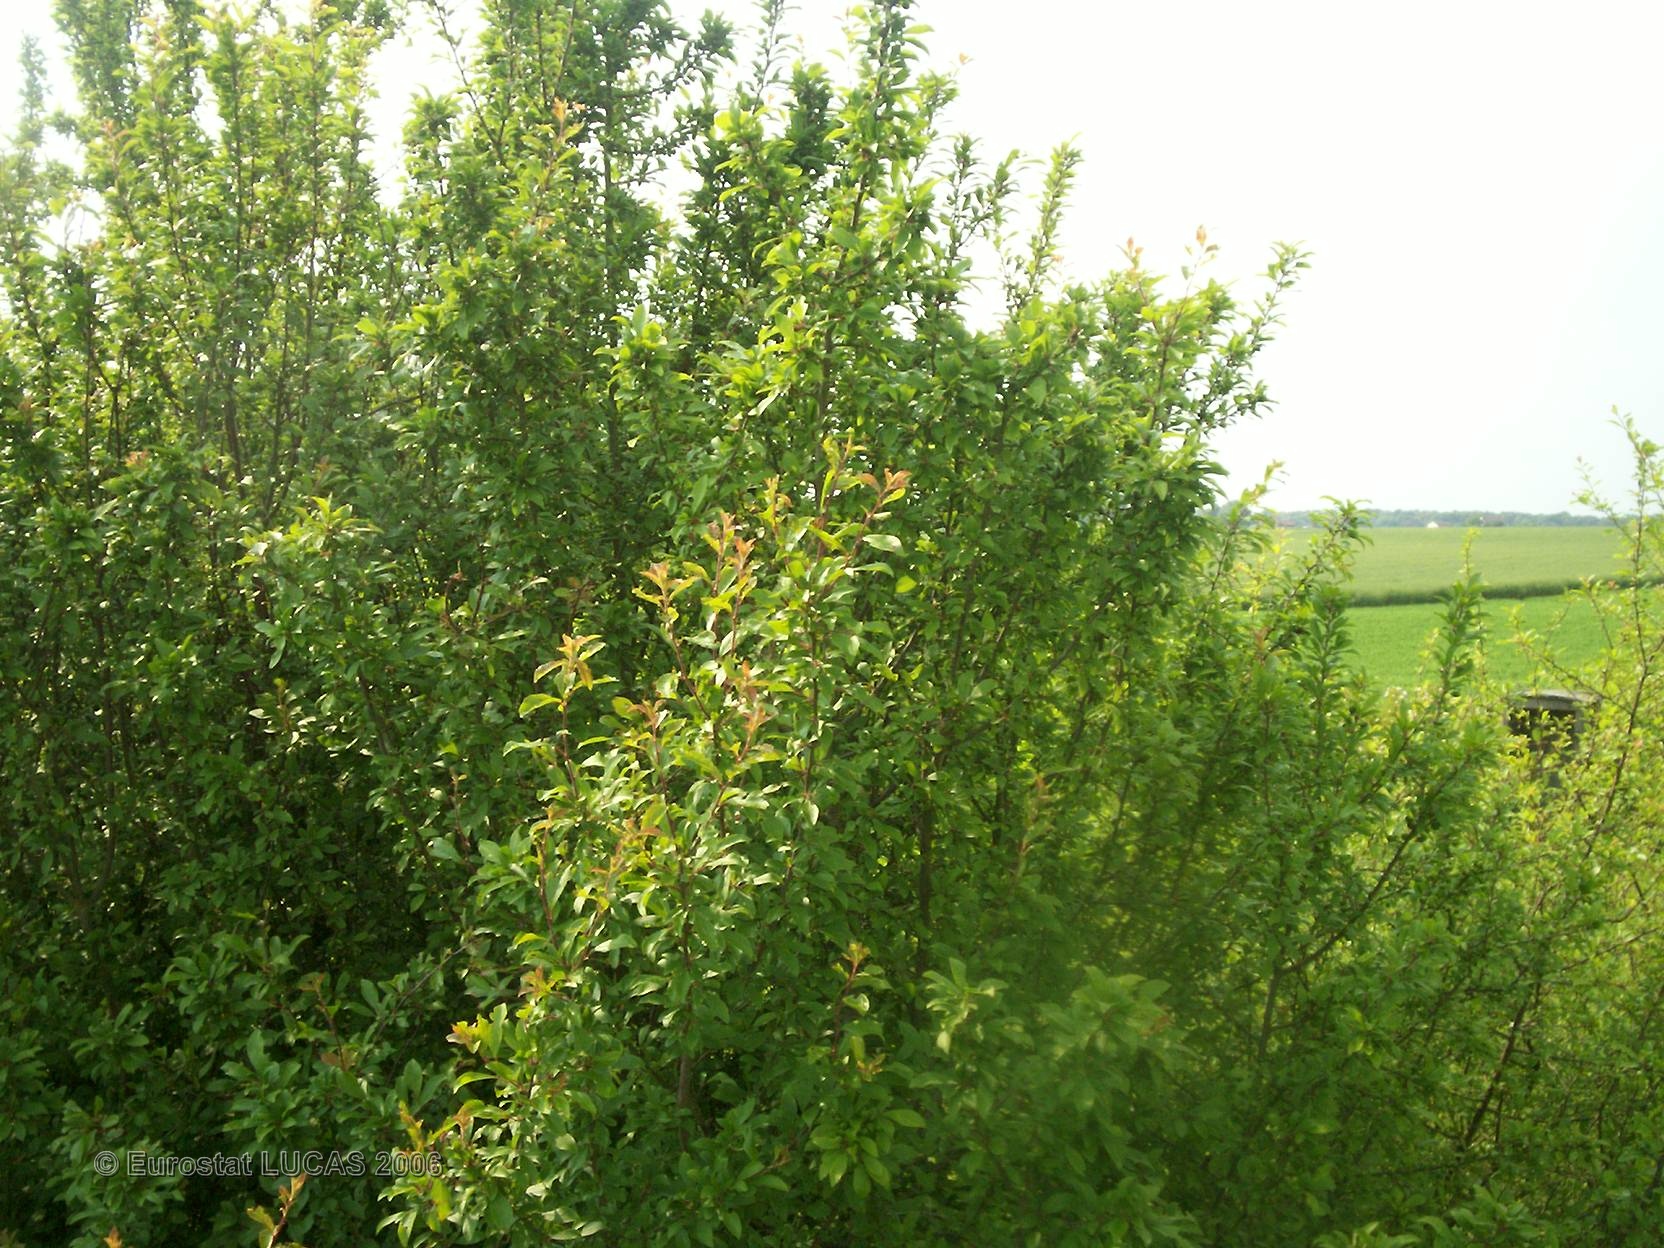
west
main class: Grassland
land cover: Grassland with sparse tree/shrub cover
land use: Railway transport
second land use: Transport via pipelines
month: June
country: FR
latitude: 49.6604
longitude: 2.6881
